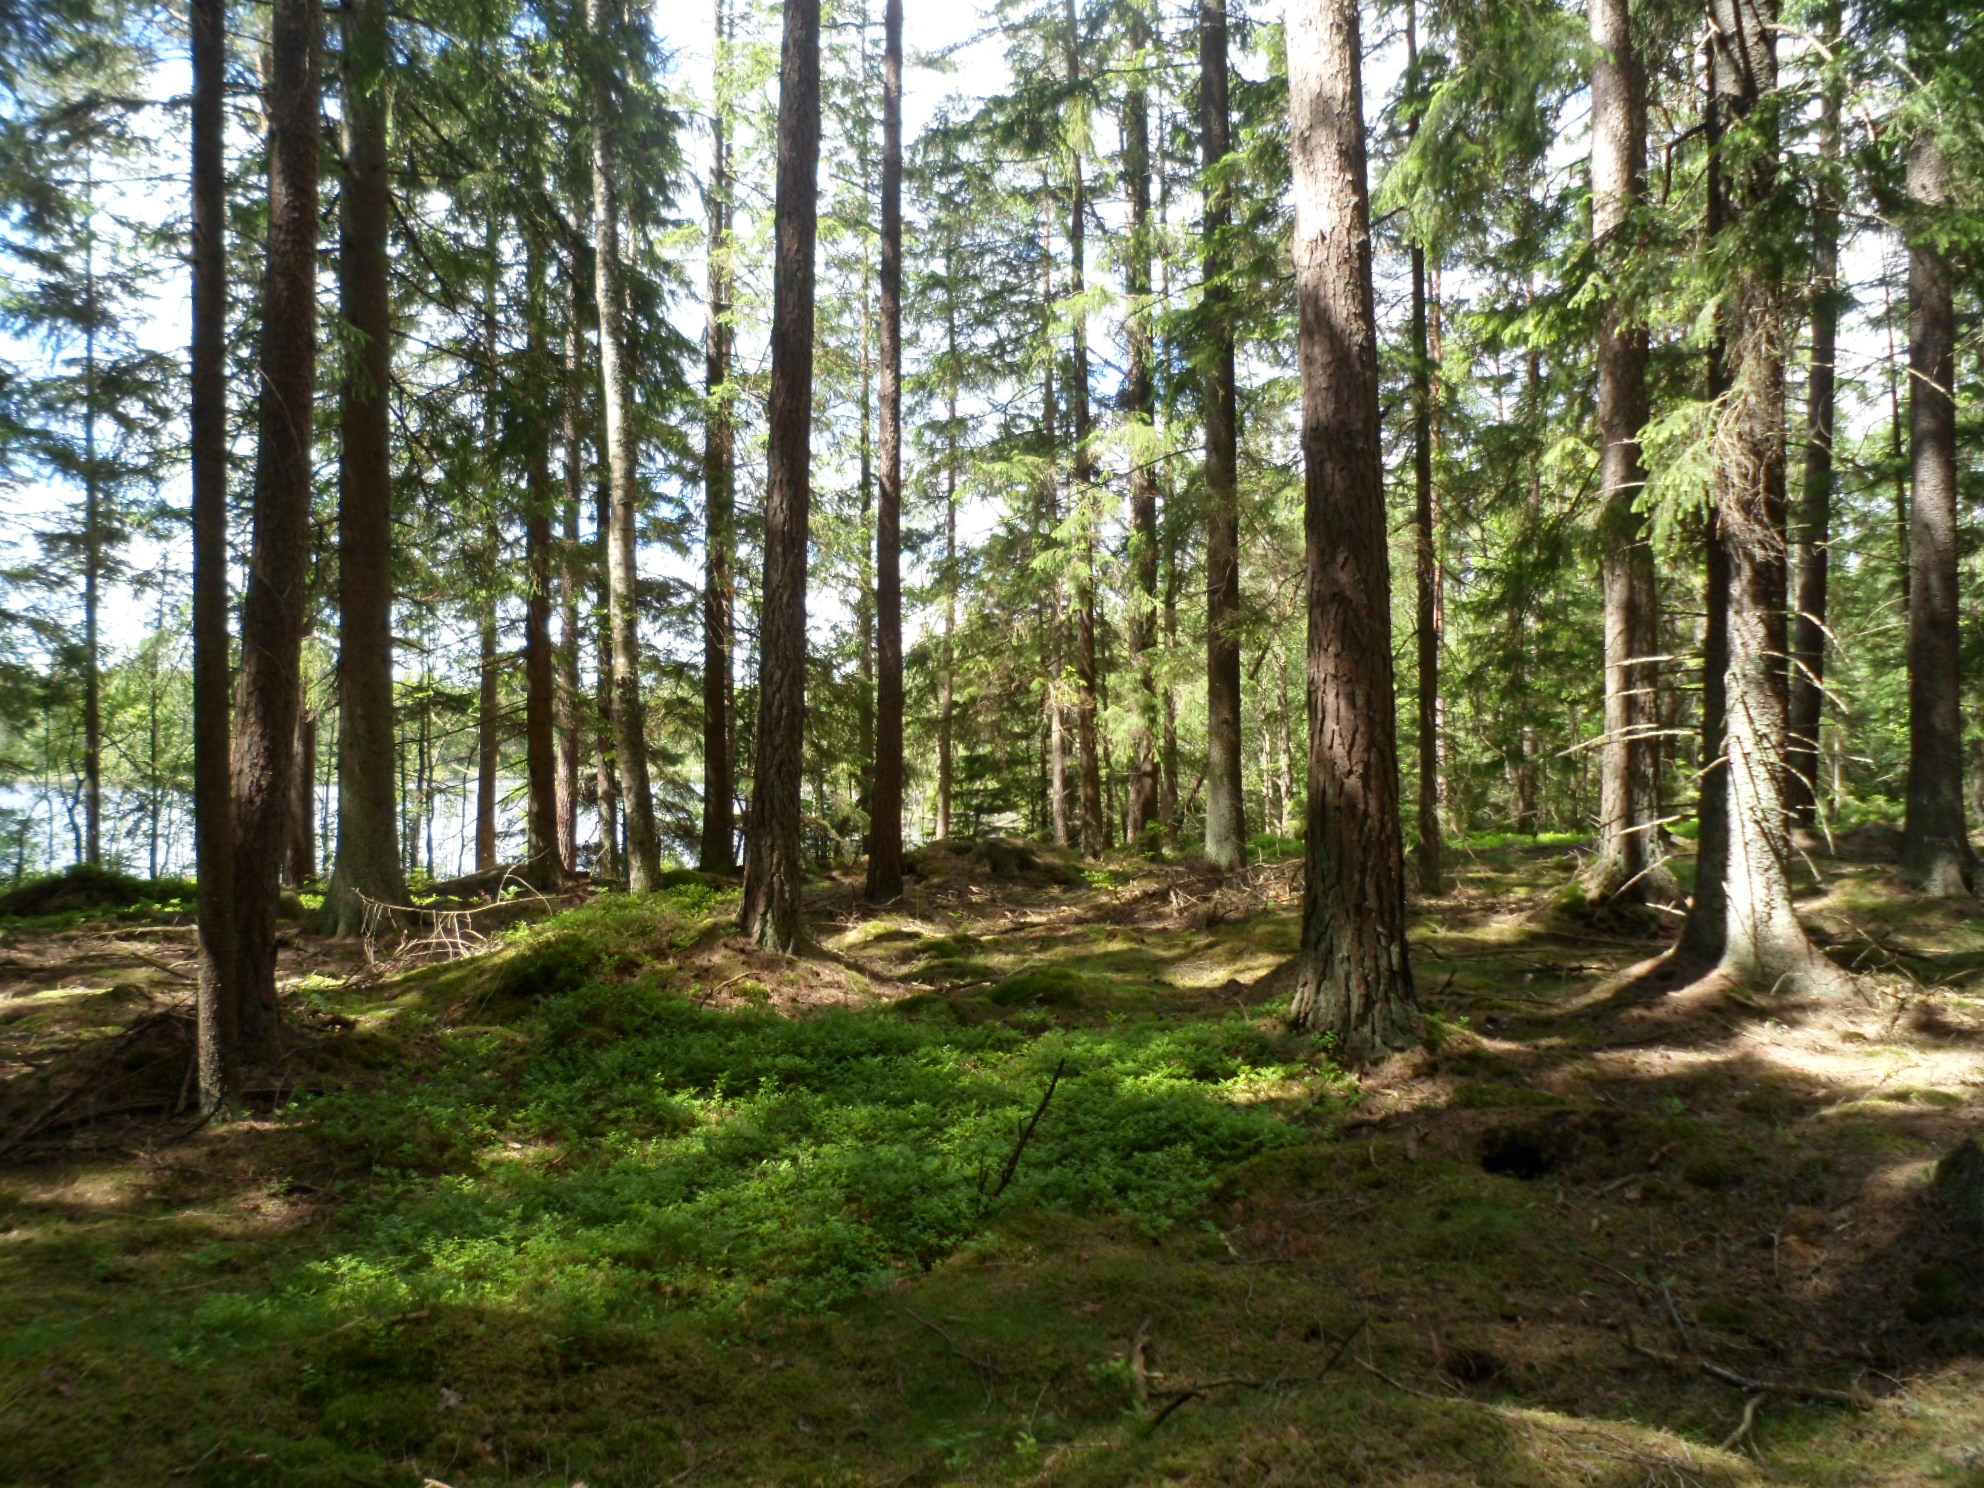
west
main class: Woodland
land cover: Pine dominated coniferous woodland
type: boreal forest
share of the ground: 25 - 50 %
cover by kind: coniferous forest trees 50 %, lichens and mosses 25 %, shrubs 15 %, consolidated bare surface 10 %
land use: Forestry
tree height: > 5 m
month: June
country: SE
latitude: 57.1809
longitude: 14.2146
